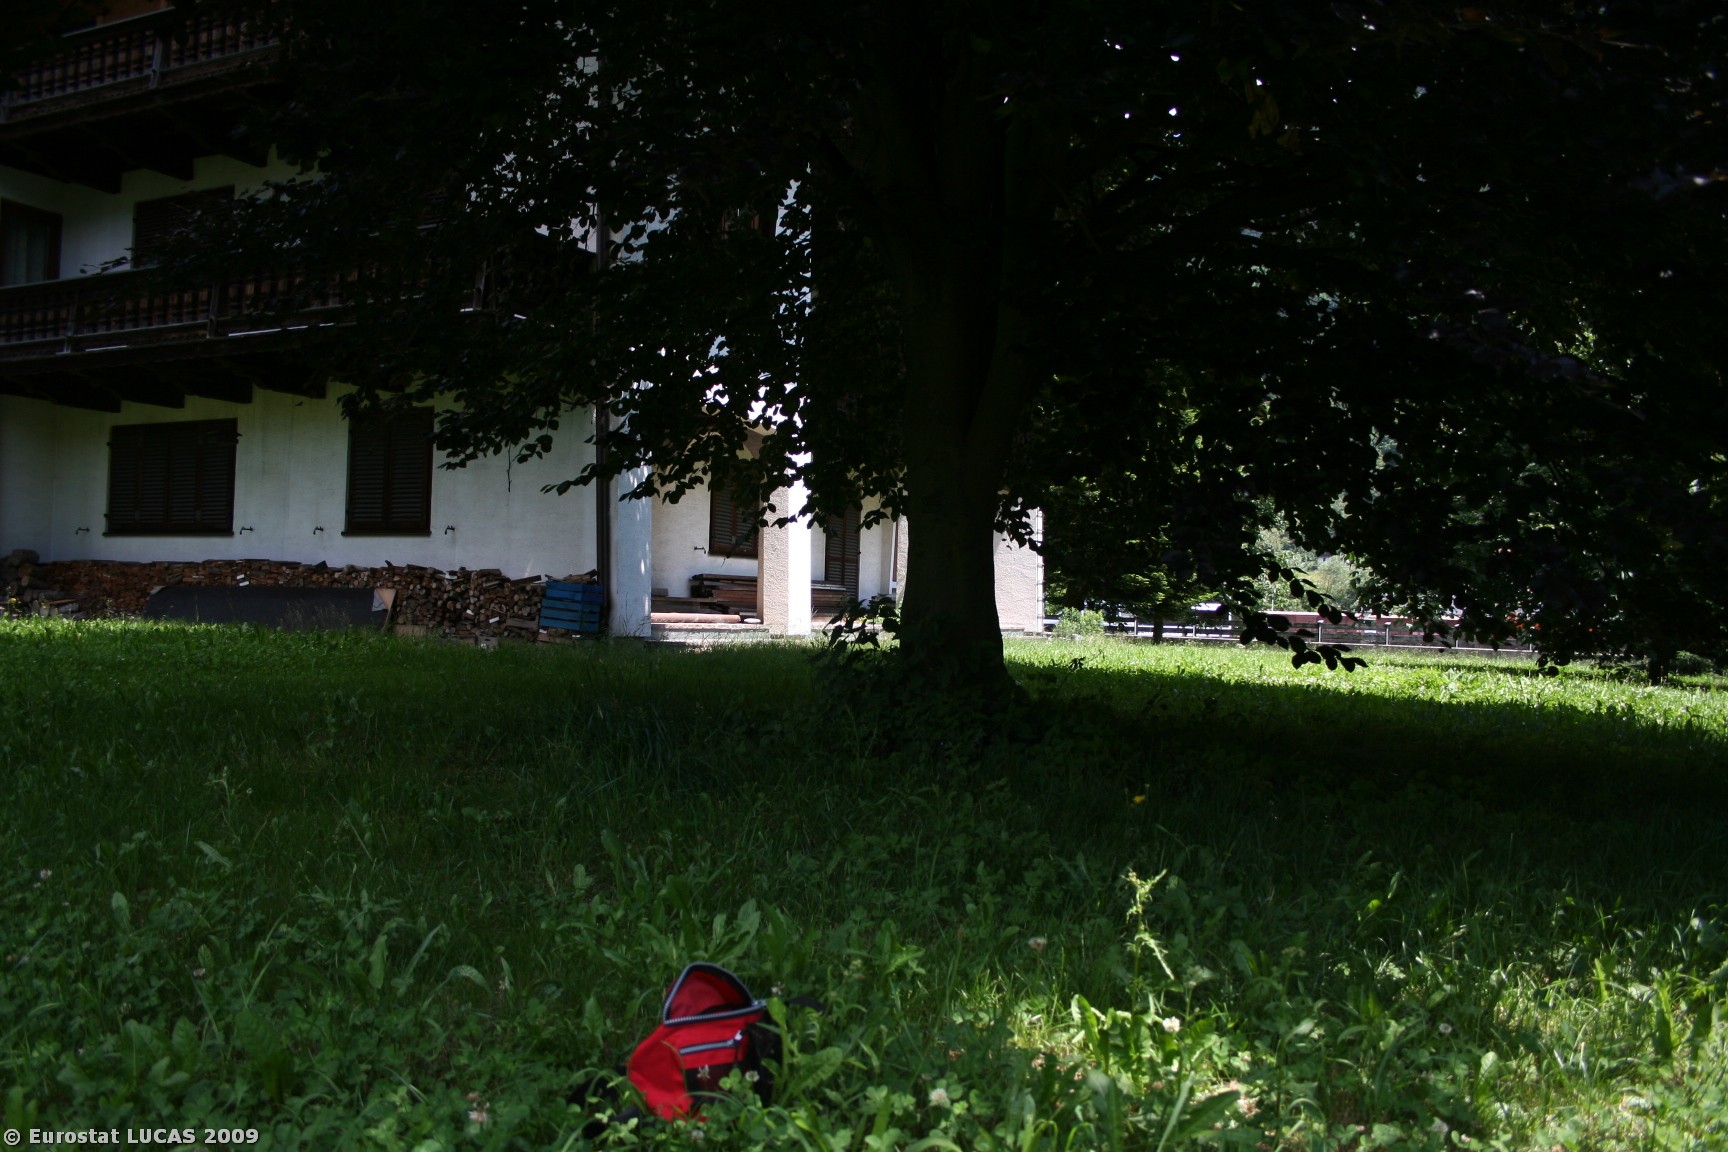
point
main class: Grassland
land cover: Grassland with sparse tree/shrub cover
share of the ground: > 75 %
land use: Agriculture (excluding fallow land and kitchen gardens)
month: June
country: AT
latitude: 47.3256
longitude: 11.8641
